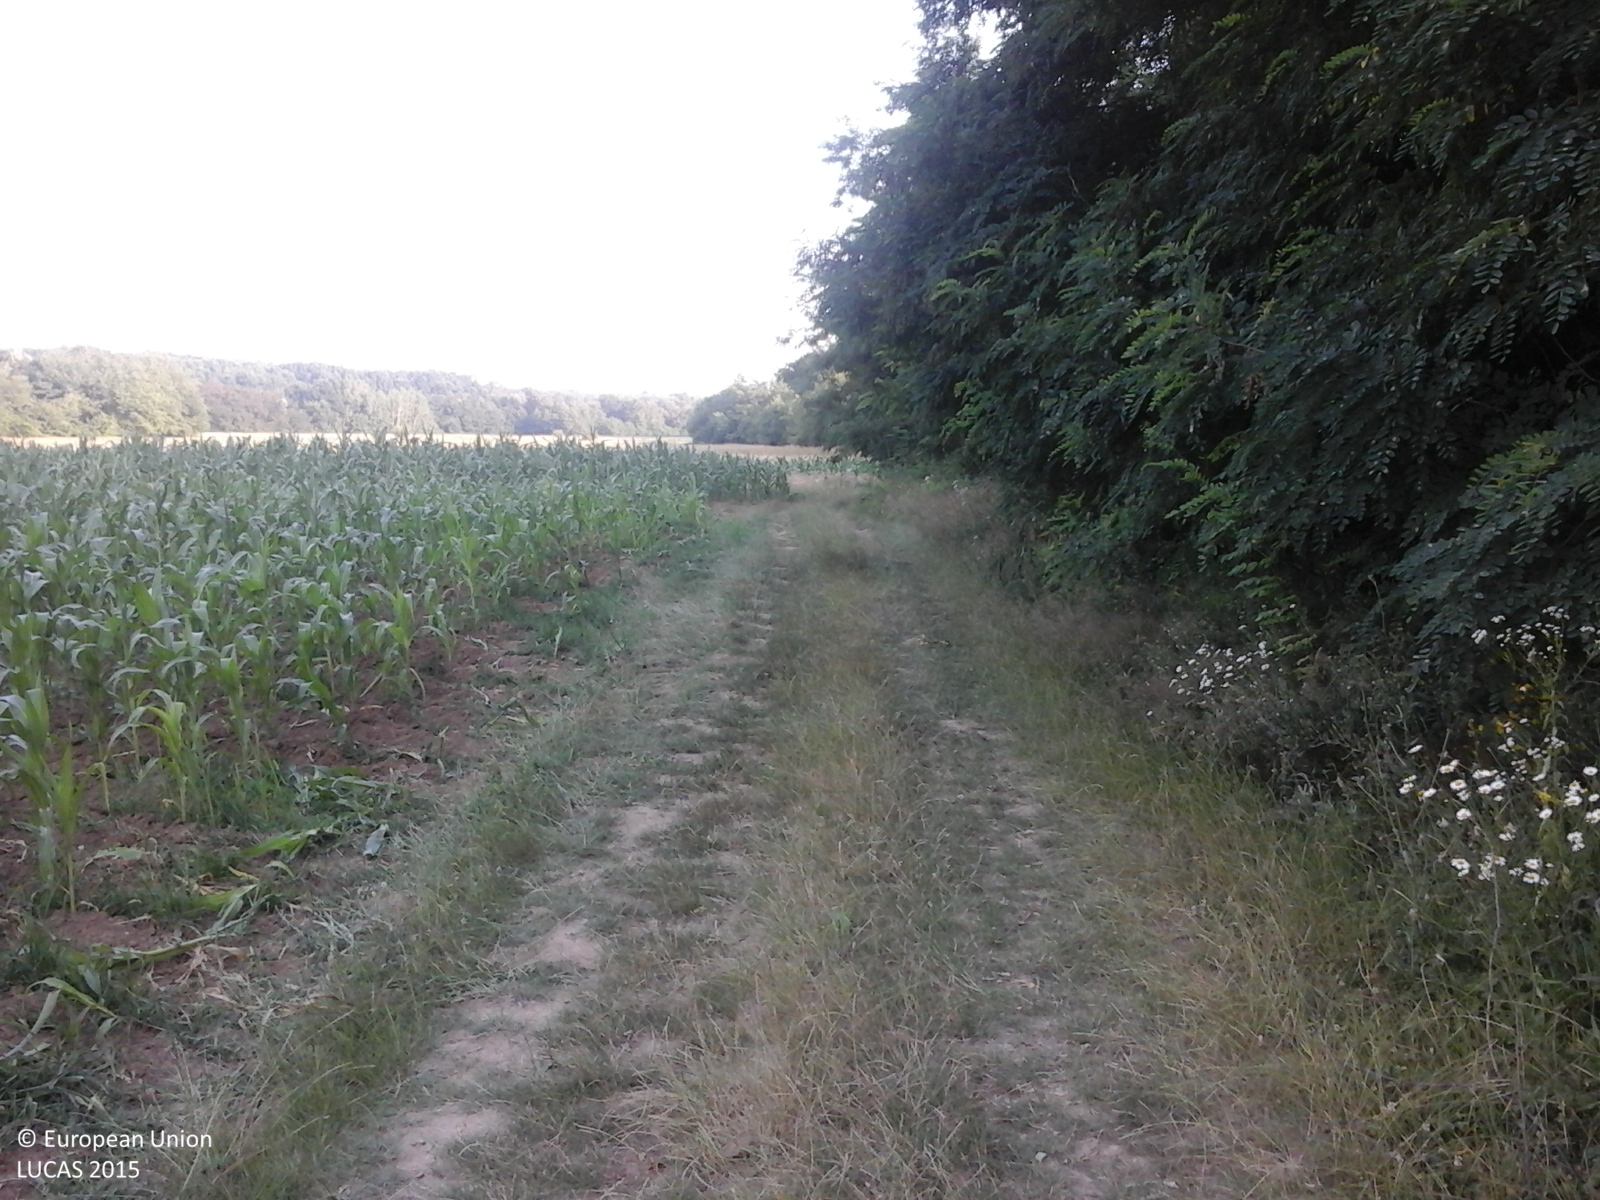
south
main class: Cropland
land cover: Maize
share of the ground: > 75 %
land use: Agriculture (excluding fallow land and kitchen gardens)
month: July
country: RO
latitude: 44.8081
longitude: 24.7583
